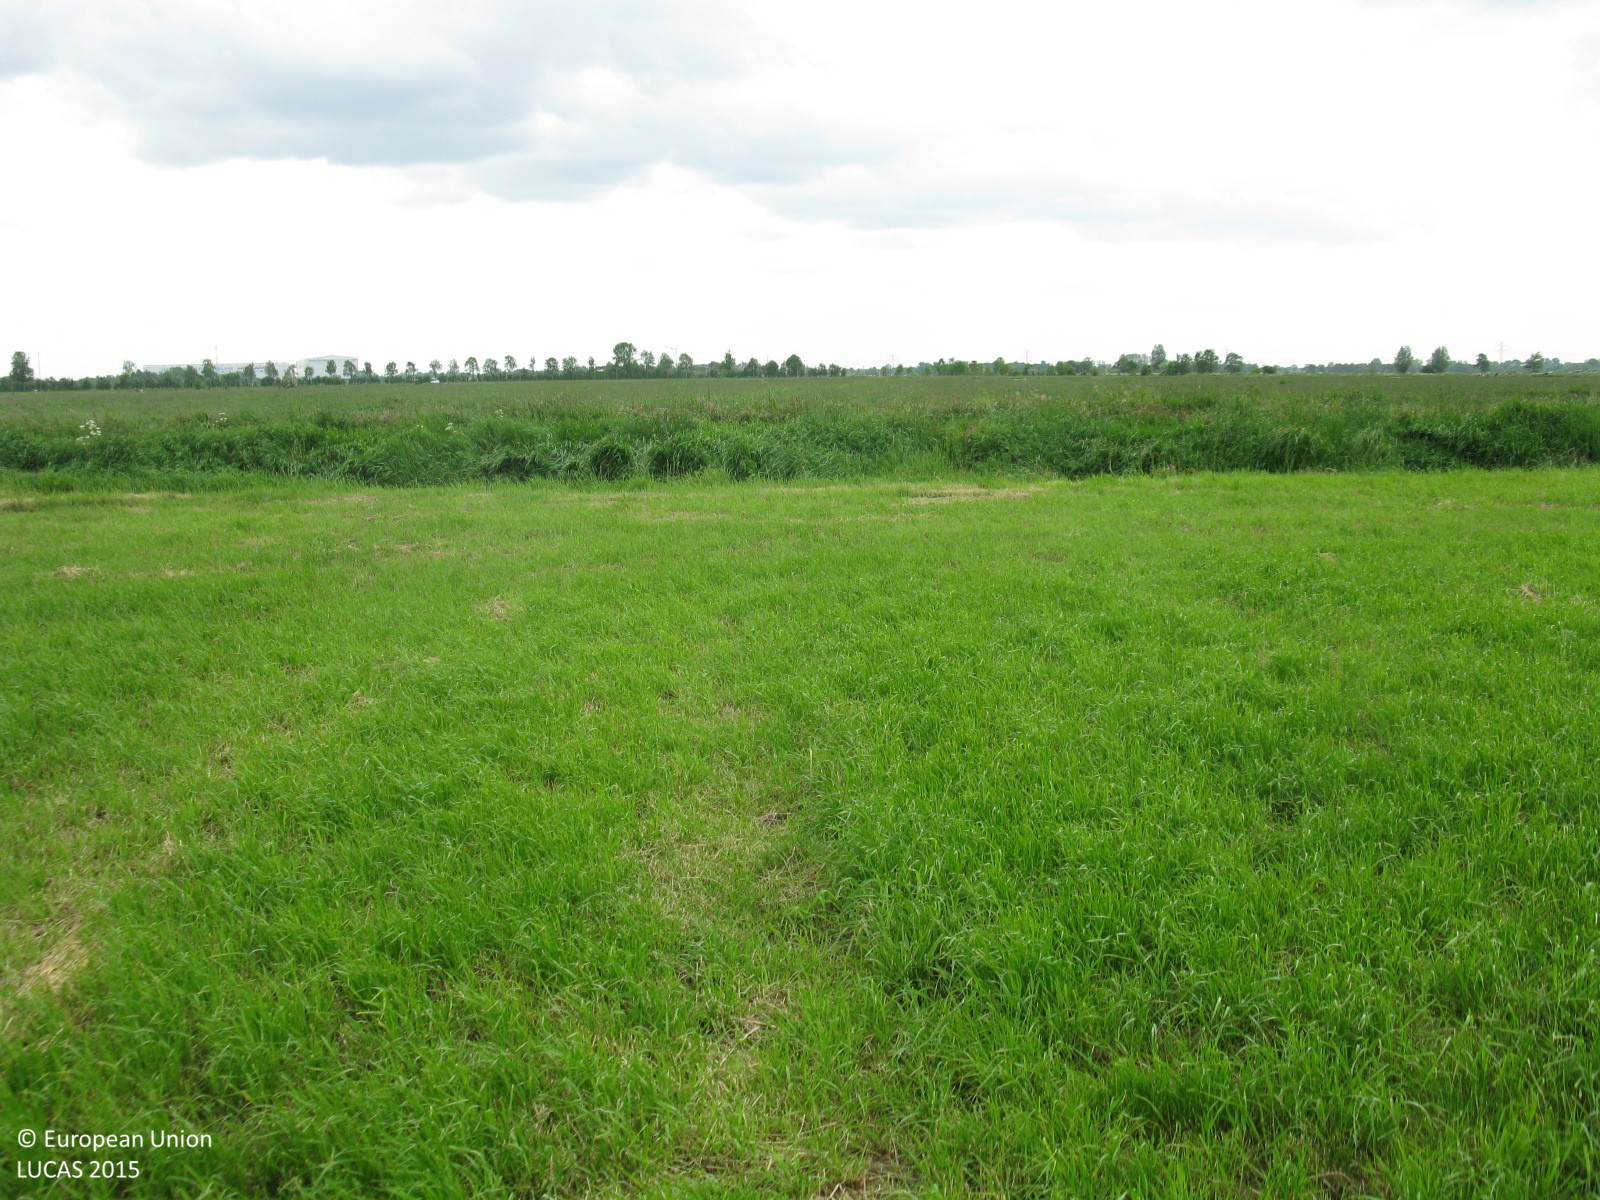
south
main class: Grassland
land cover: Grassland without tree/shrub cover
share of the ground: > 75 %
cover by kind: herbaceous plants 100 %
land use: Agriculture (excluding fallow land and kitchen gardens)
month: June
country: DE
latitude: 53.1393
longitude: 7.3546
